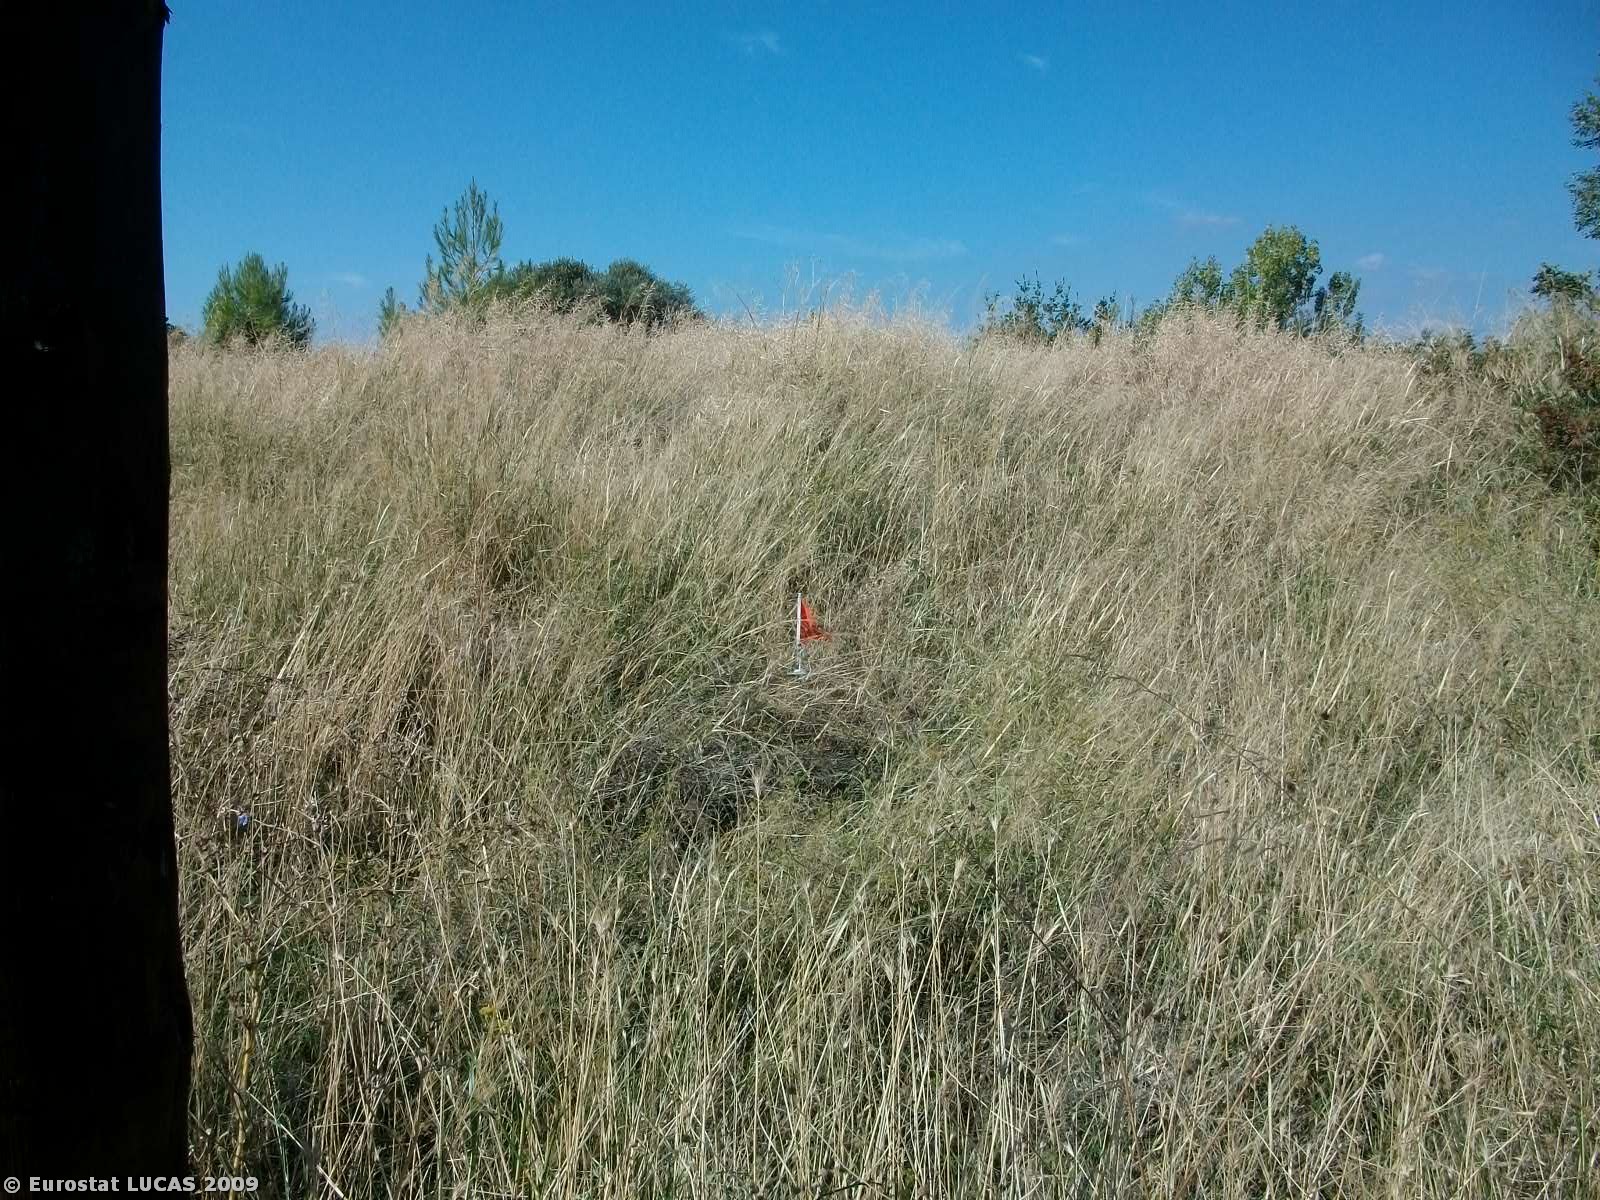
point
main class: Grassland
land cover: Grassland without tree/shrub cover
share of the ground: > 75 %
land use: Unused
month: September
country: GR
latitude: 38.2887
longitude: 23.8547
